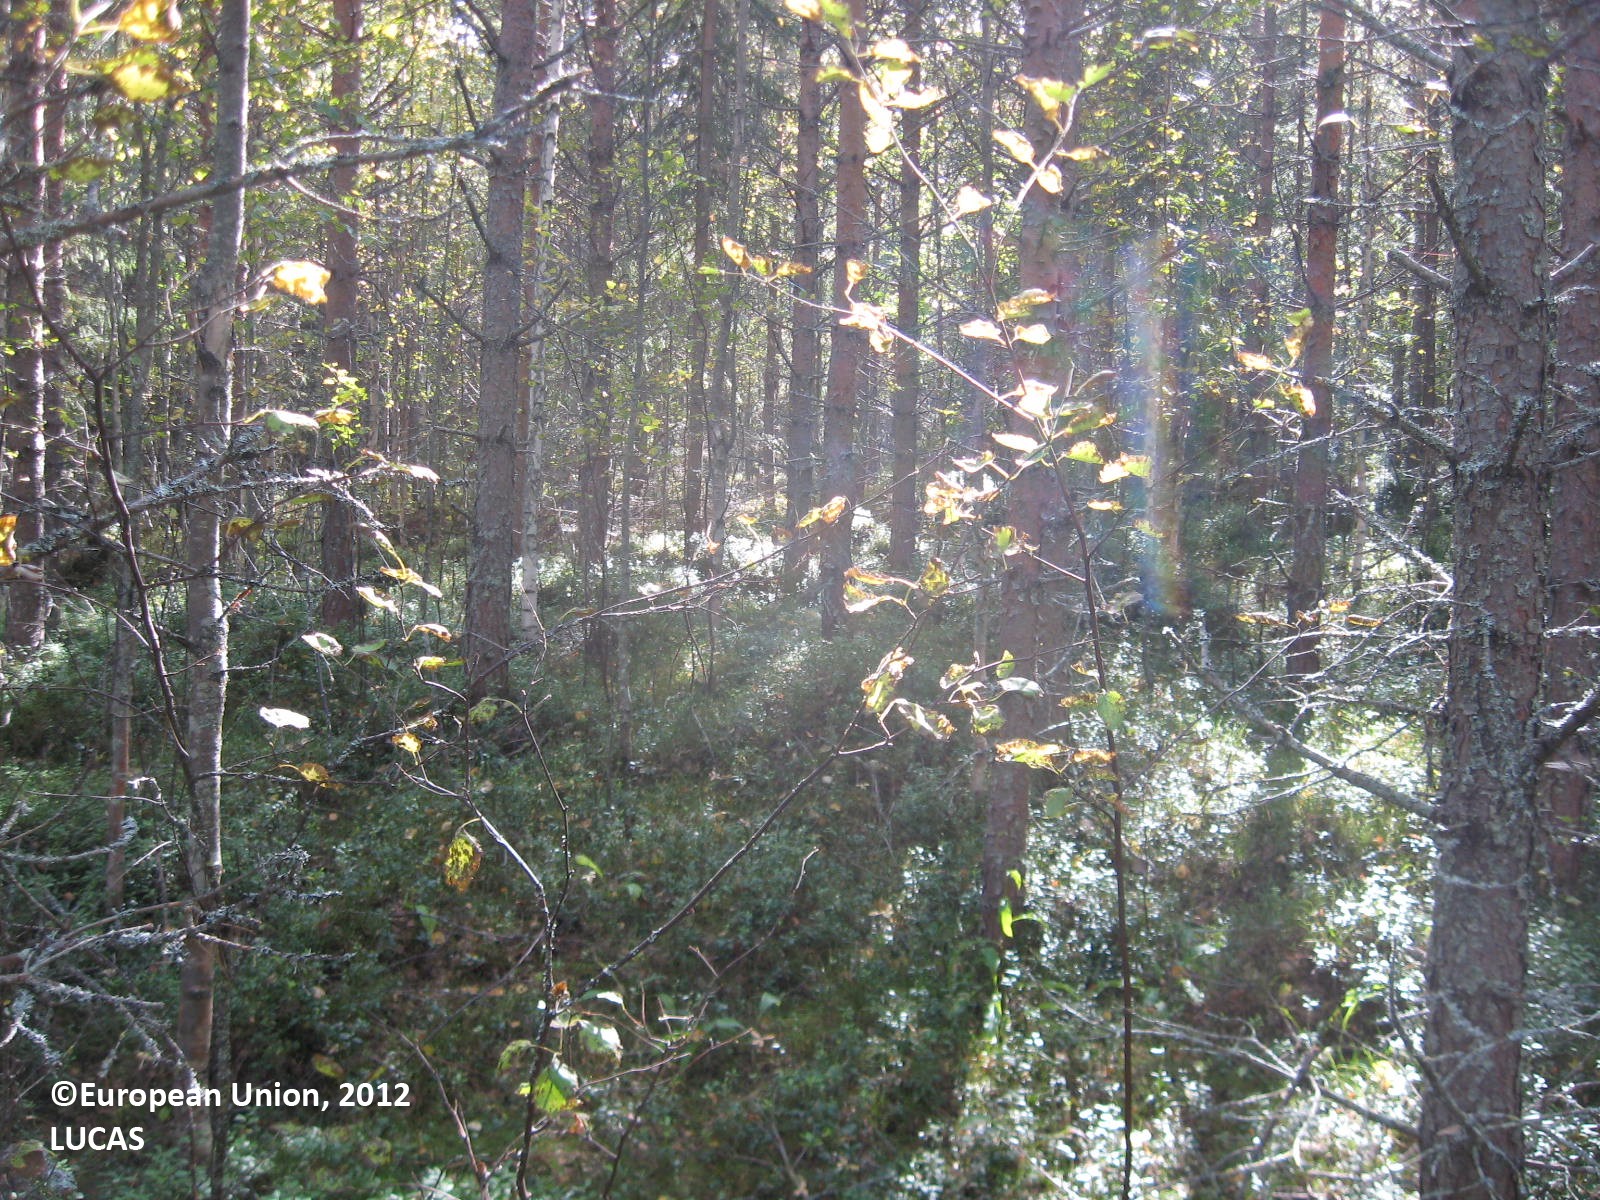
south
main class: Woodland
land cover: Pine dominated coniferous woodland
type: boreal forest
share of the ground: > 75 %
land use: Forestry
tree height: > 5 m
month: August
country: FI
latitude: 63.8021
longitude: 29.9556
